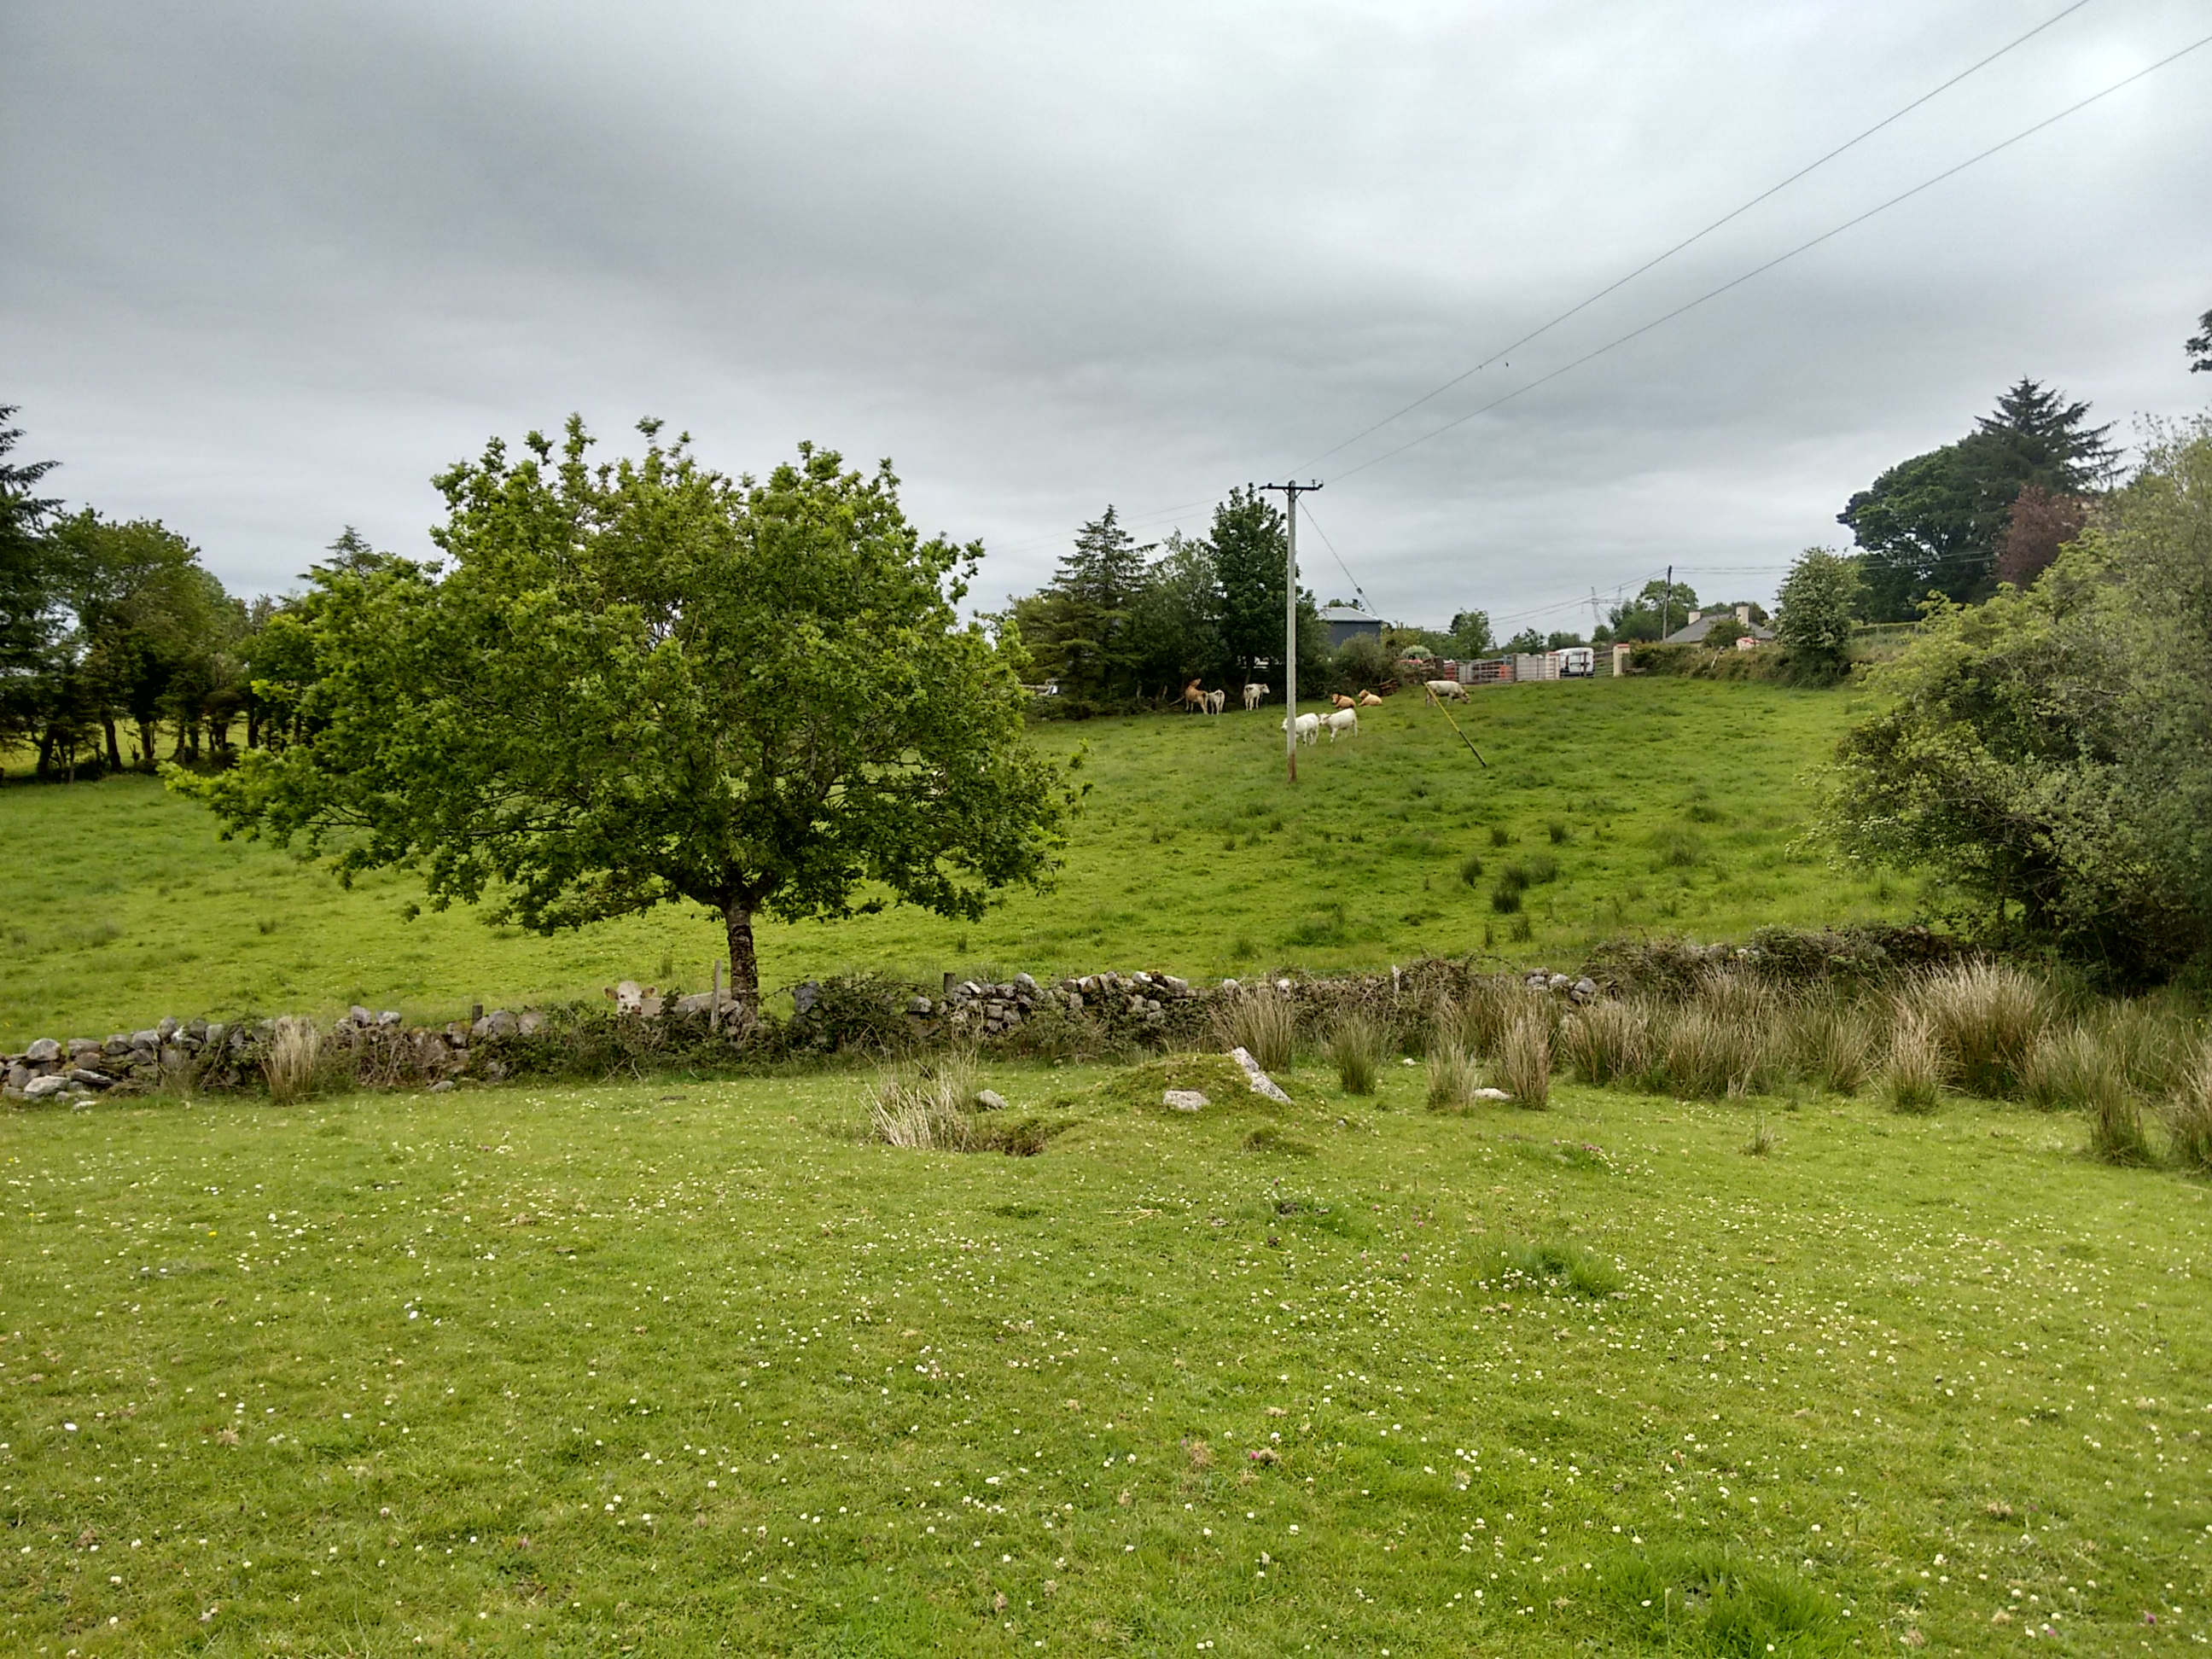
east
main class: Grassland
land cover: Grassland with sparse tree/shrub cover
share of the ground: > 75 %
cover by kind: herbaceous plants 85 %, shrubs 10 %, broadleaved forest trees 5 %
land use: Agriculture (excluding fallow land and kitchen gardens)
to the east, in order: Grassland with sparse tree/shrub cover; Dry stone walls; Fences; Grassland without tree/shrub cover; Electric lines; Grassland without tree/shrub cover; Dry stone walls; Lines of trees; Rivers and streams; Artificial constructions in urban areas; Grassland without tree/shrub cover; Artificial constructions in urban areas; Grassland with sparse tree/shrub cover
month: June
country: IE
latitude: 53.0701
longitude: -8.4757
